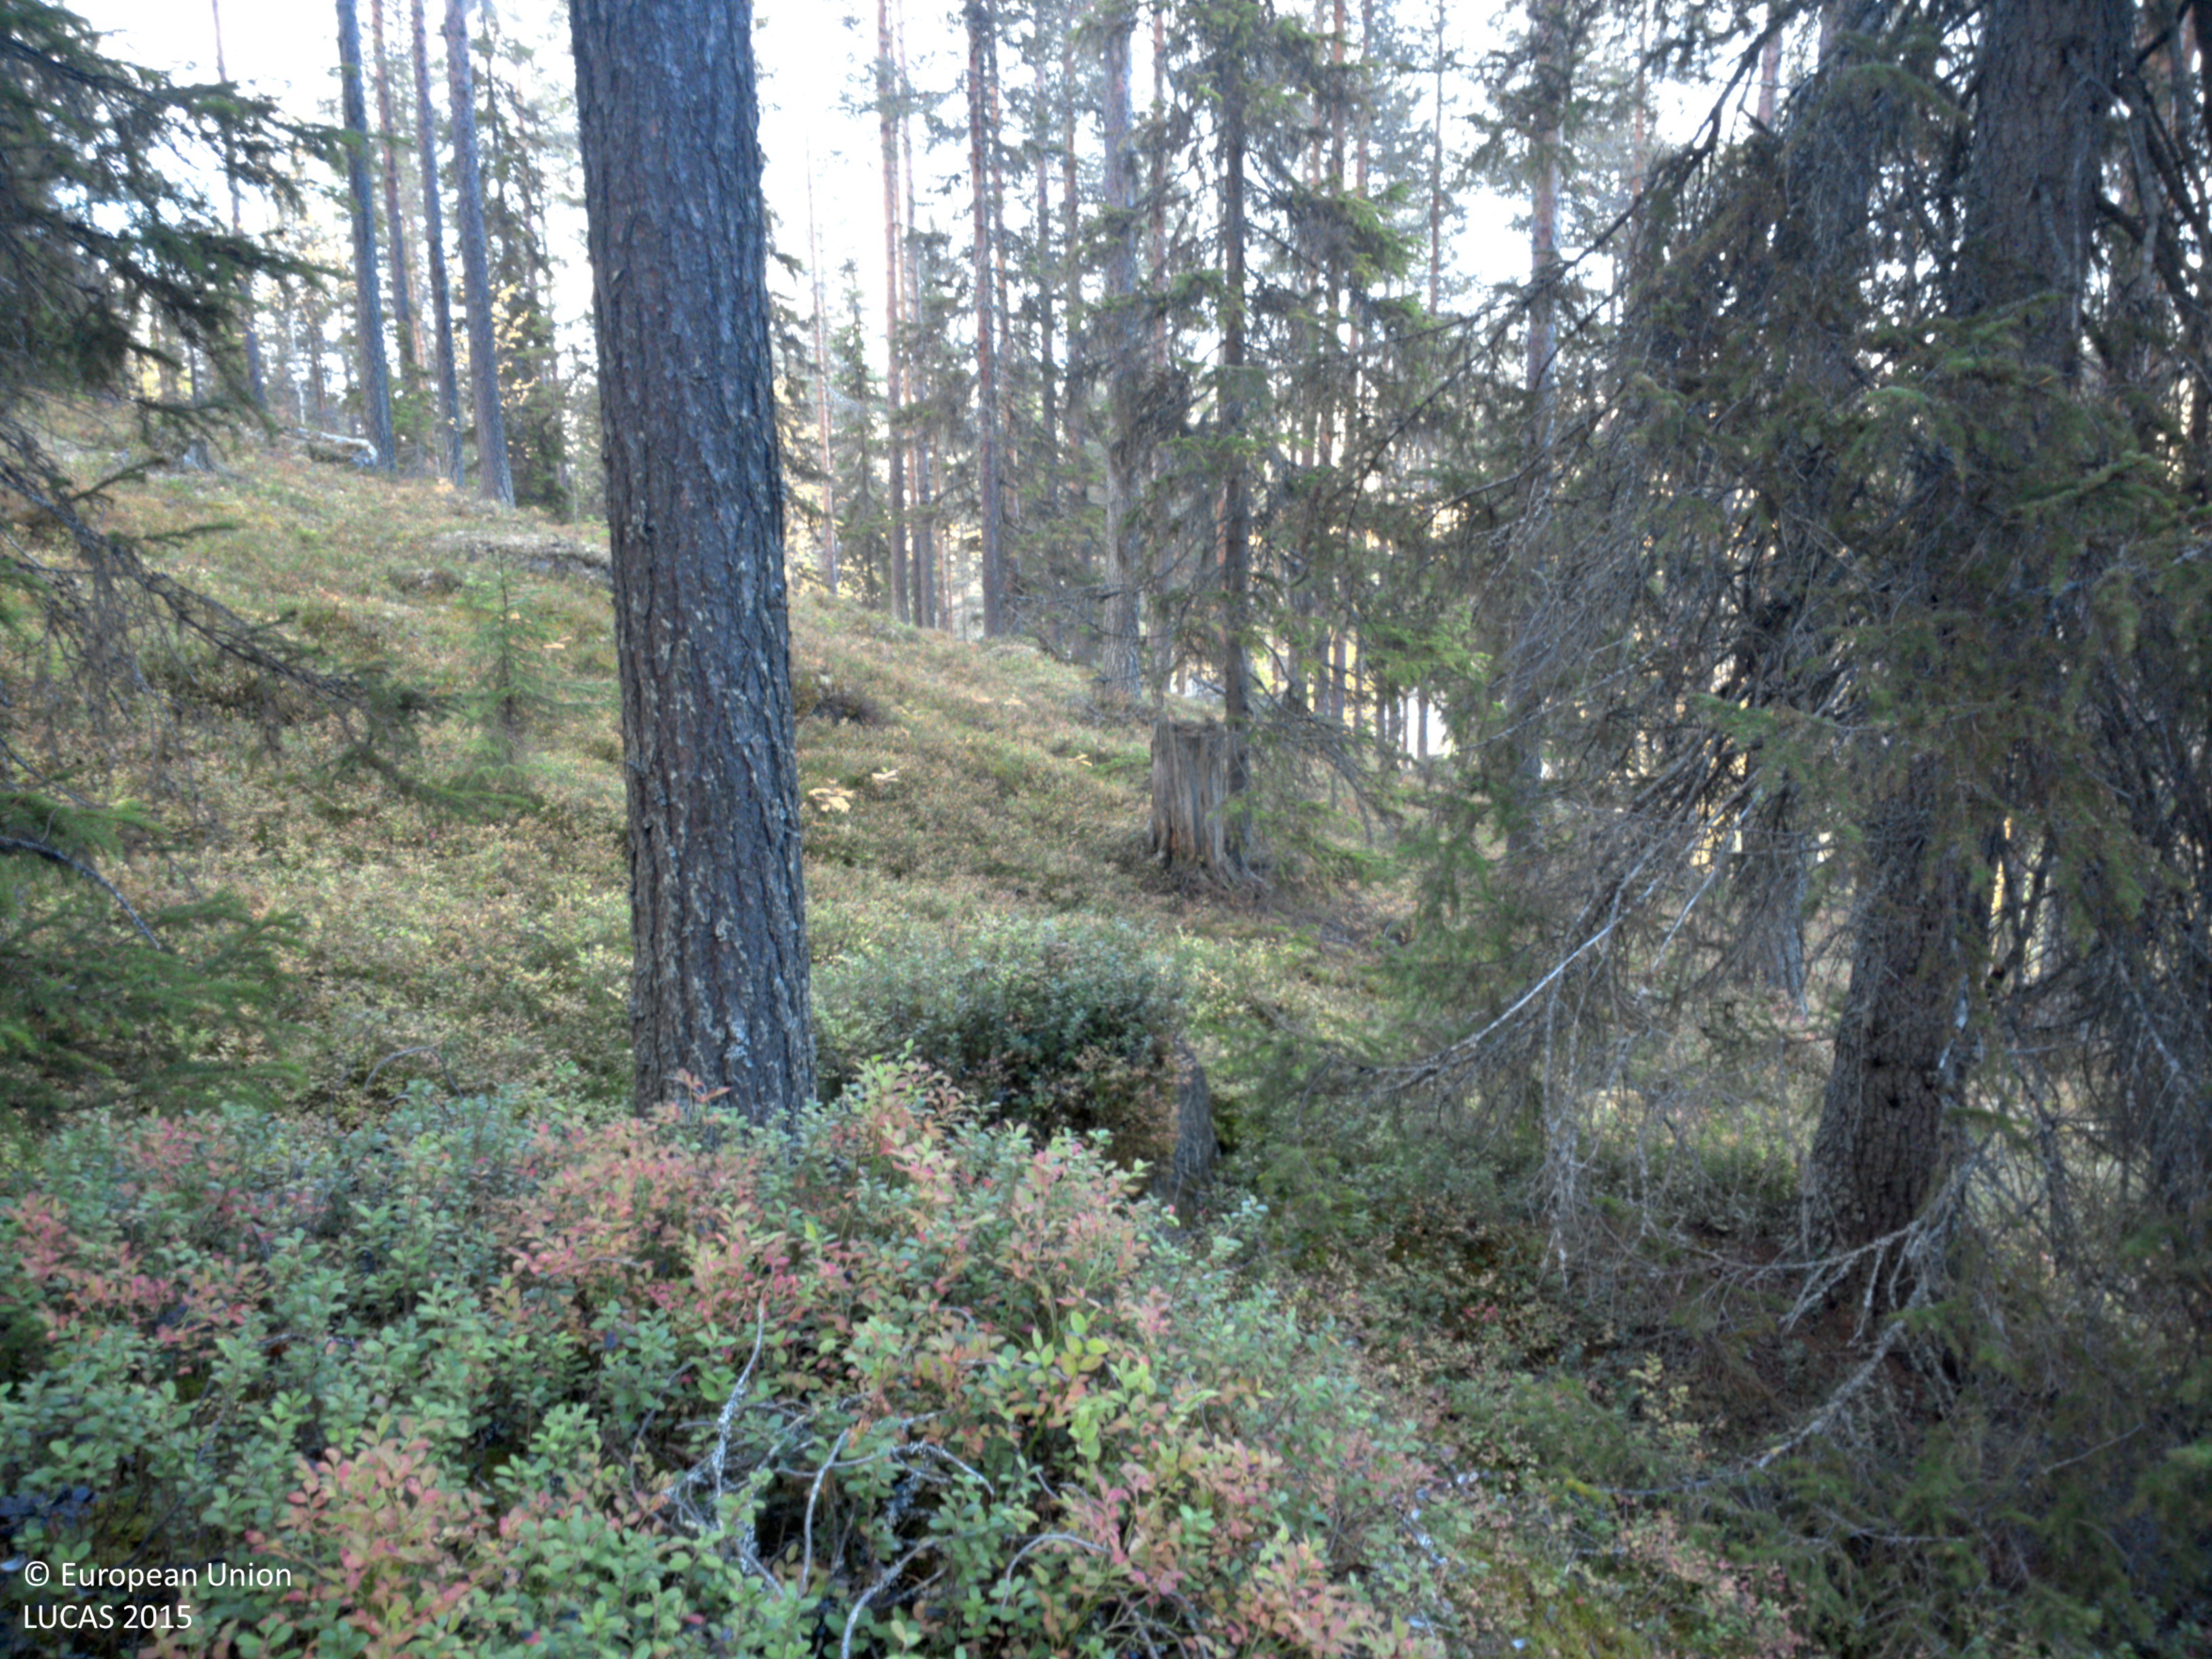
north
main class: Woodland
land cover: Other coniferous woodland
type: boreal forest
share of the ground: 50 - 75 %
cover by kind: coniferous forest trees 70 %, shrubs 20 %, lichens and mosses 10 %
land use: Forestry
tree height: > 5 m
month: September
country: SE
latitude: 64.9680
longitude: 18.5431
